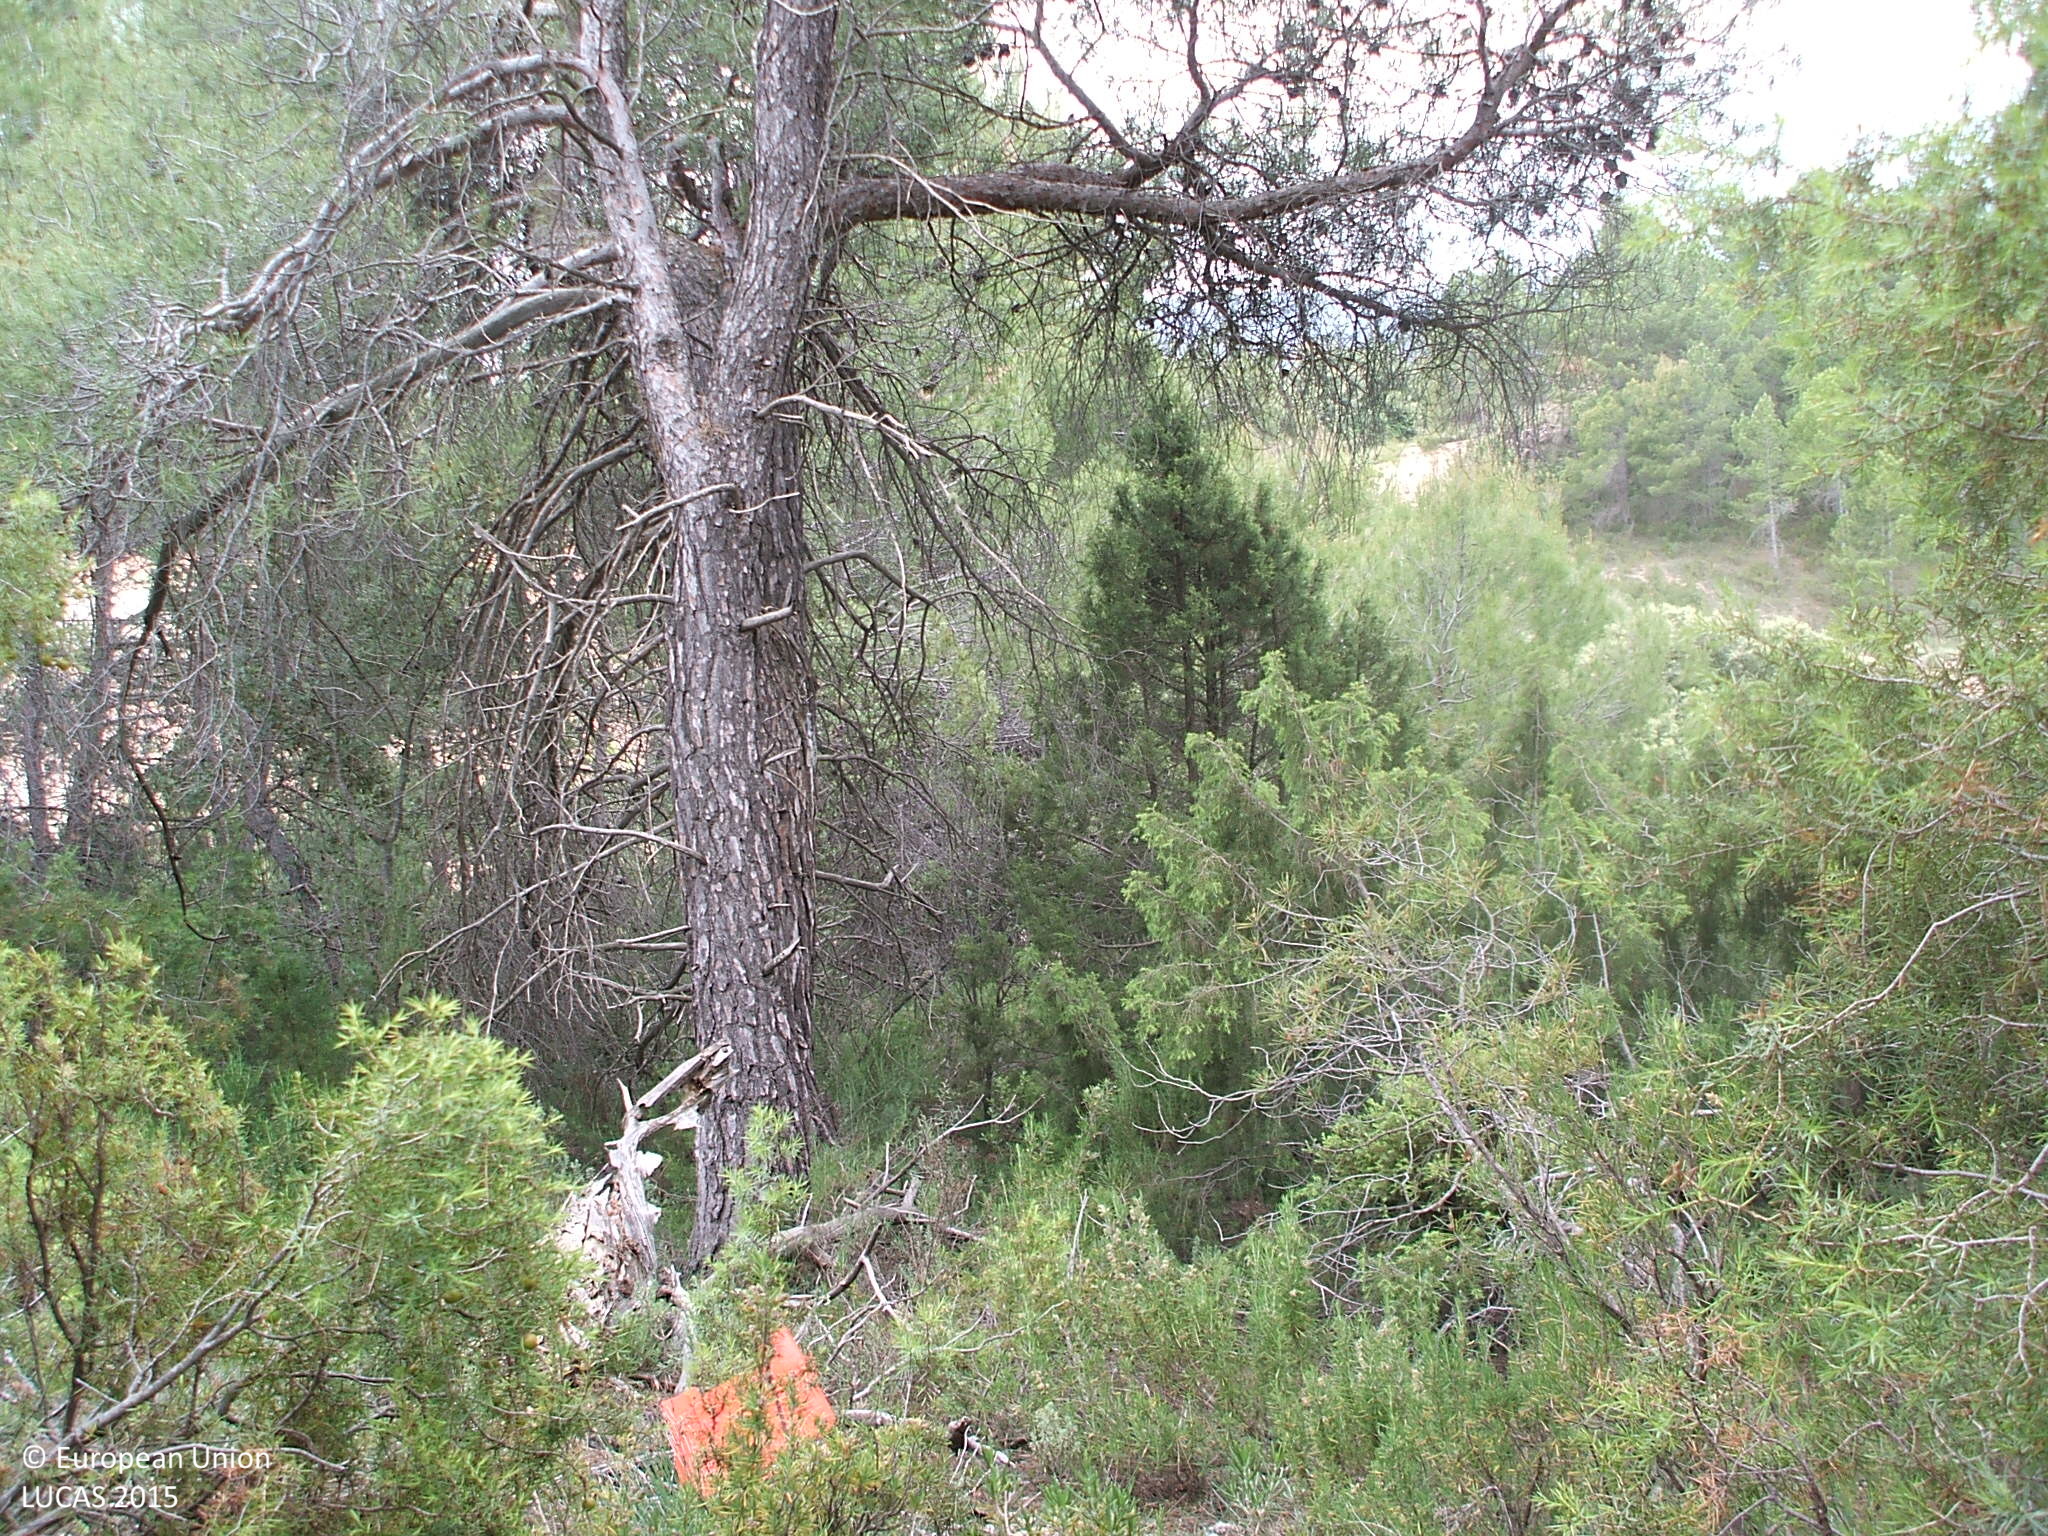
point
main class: Woodland
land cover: Pine dominated coniferous woodland
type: coniferous forest of the mediterranean region
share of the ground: > 75 %
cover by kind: coniferous forest trees 100 %
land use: Semi-natural and natural areas not in use
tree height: > 5 m
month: June
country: ES
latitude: 40.8268
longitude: -0.0284
